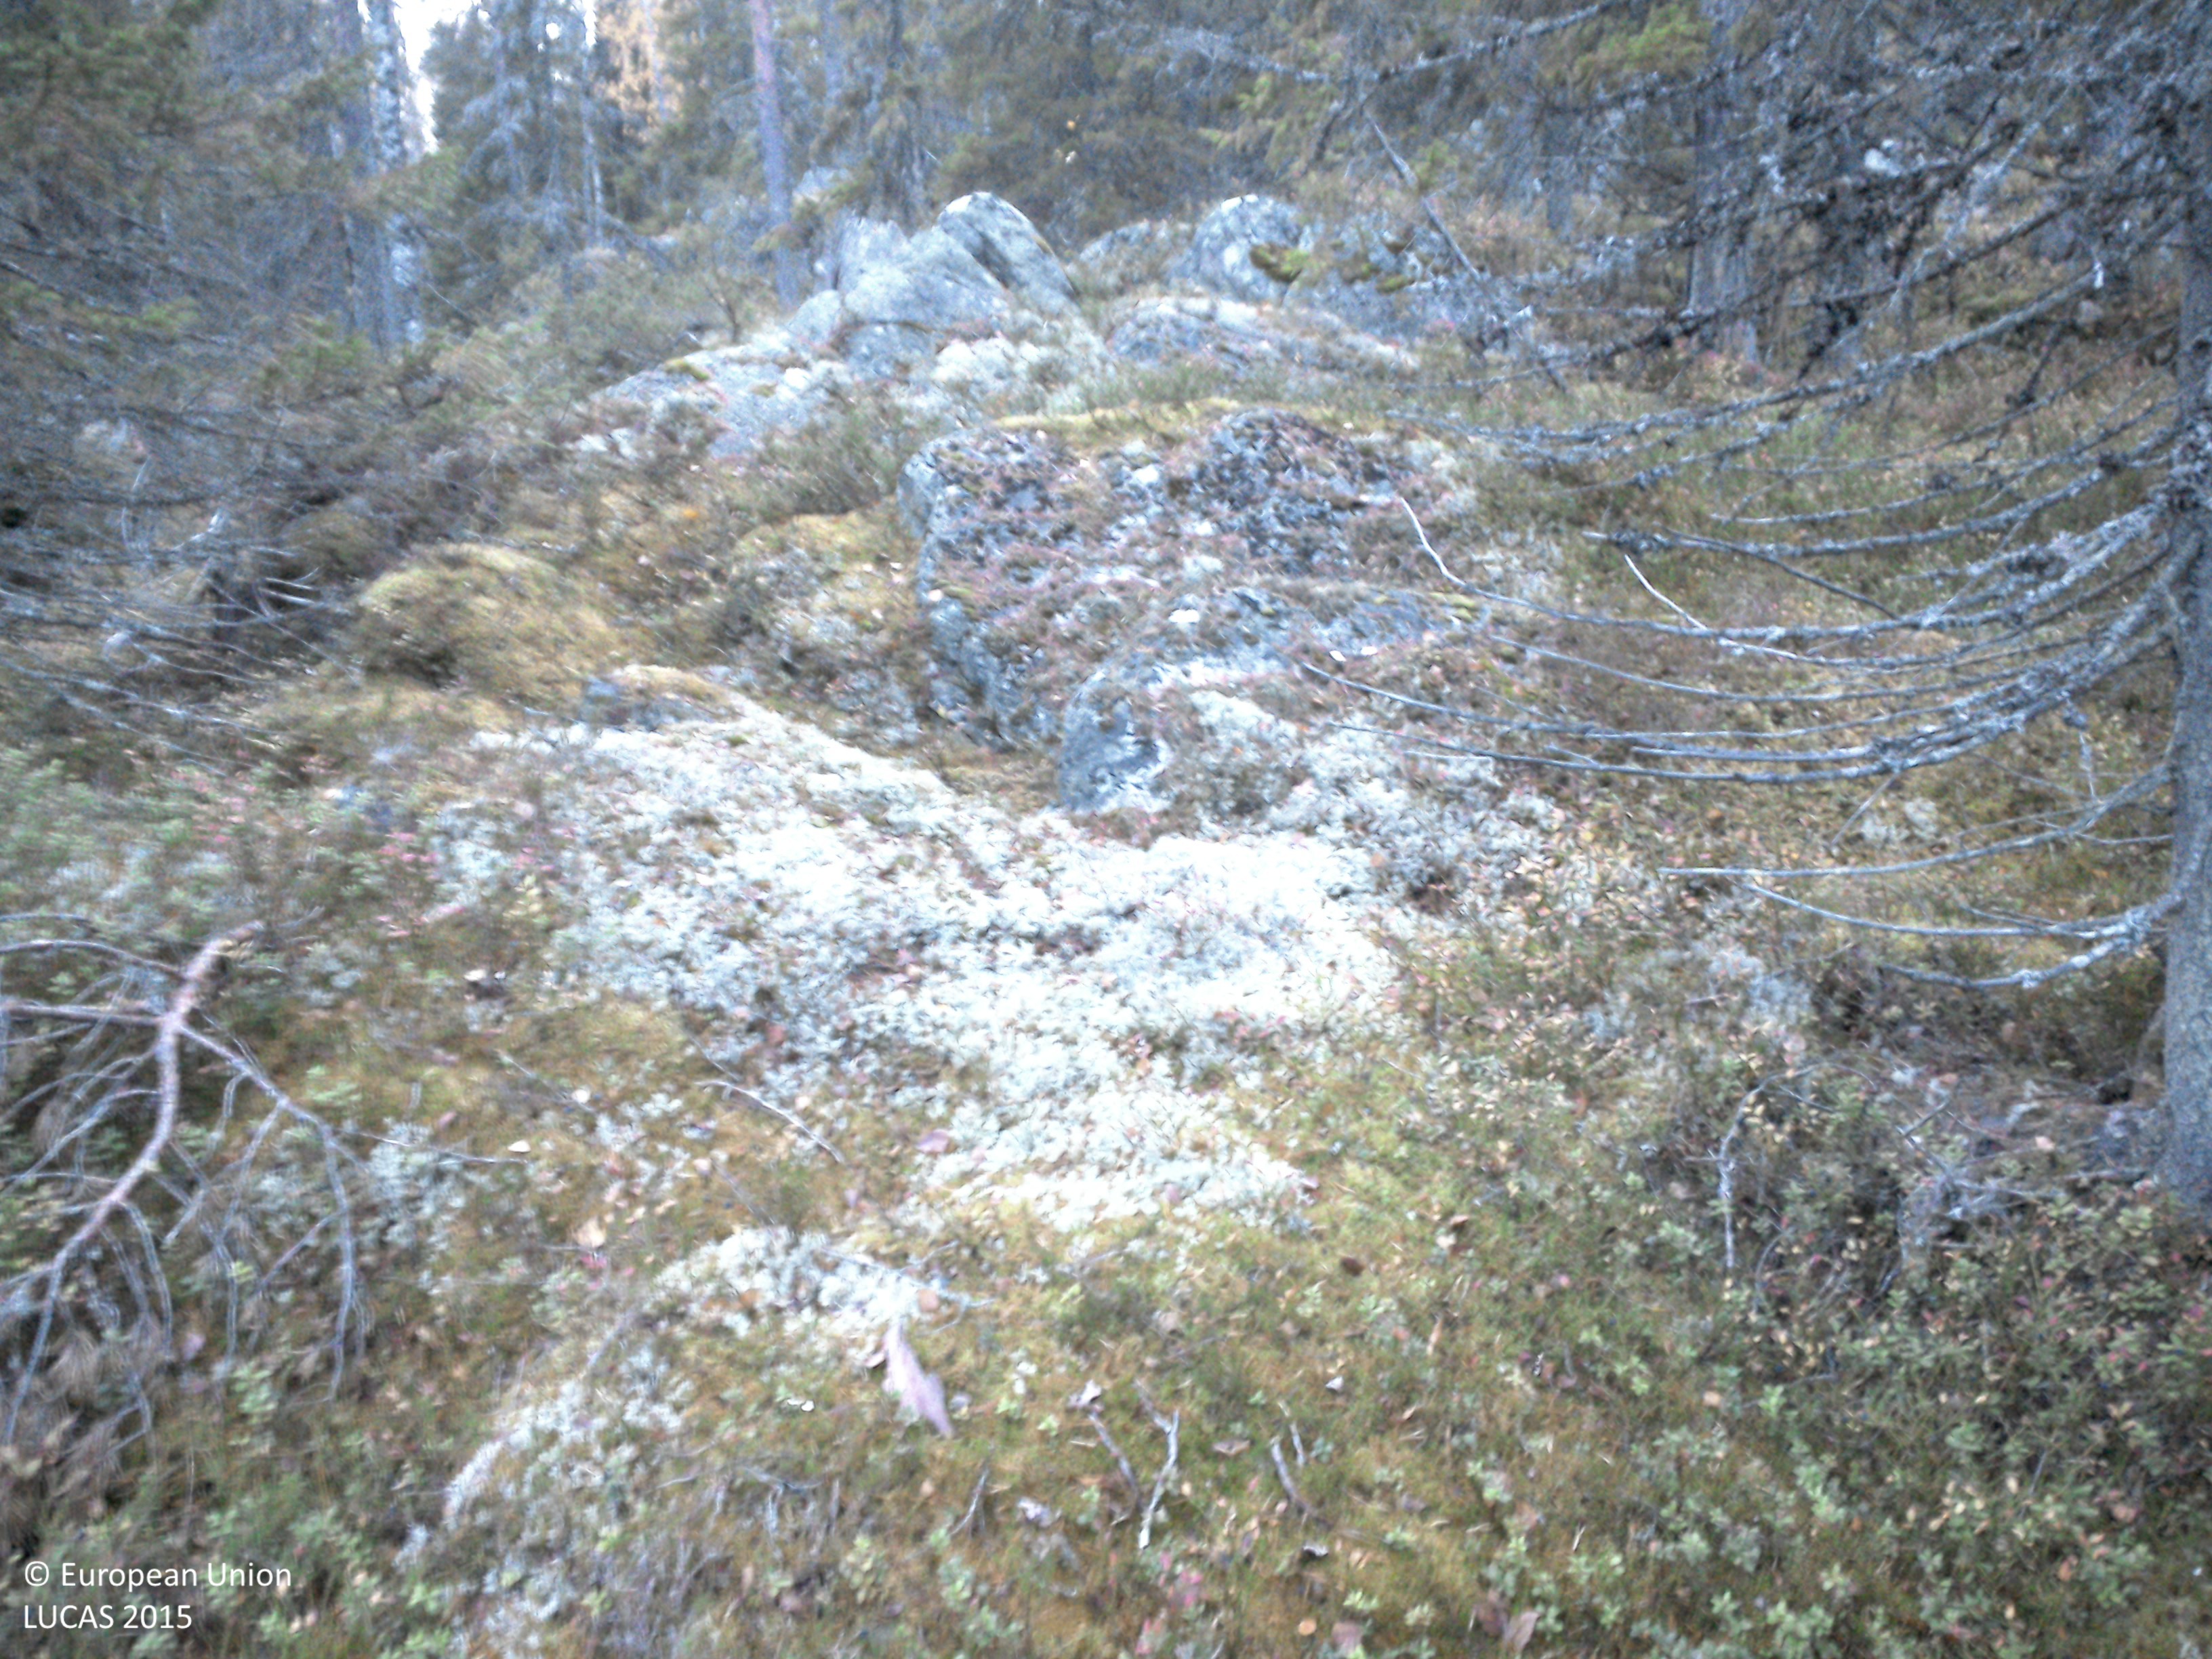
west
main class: Woodland
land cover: Other coniferous woodland
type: boreal forest
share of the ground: 50 - 75 %
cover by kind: coniferous forest trees 50 %, shrubs 50 %
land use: Forestry
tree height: > 5 m
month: October
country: SE
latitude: 63.8192
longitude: 19.8319
